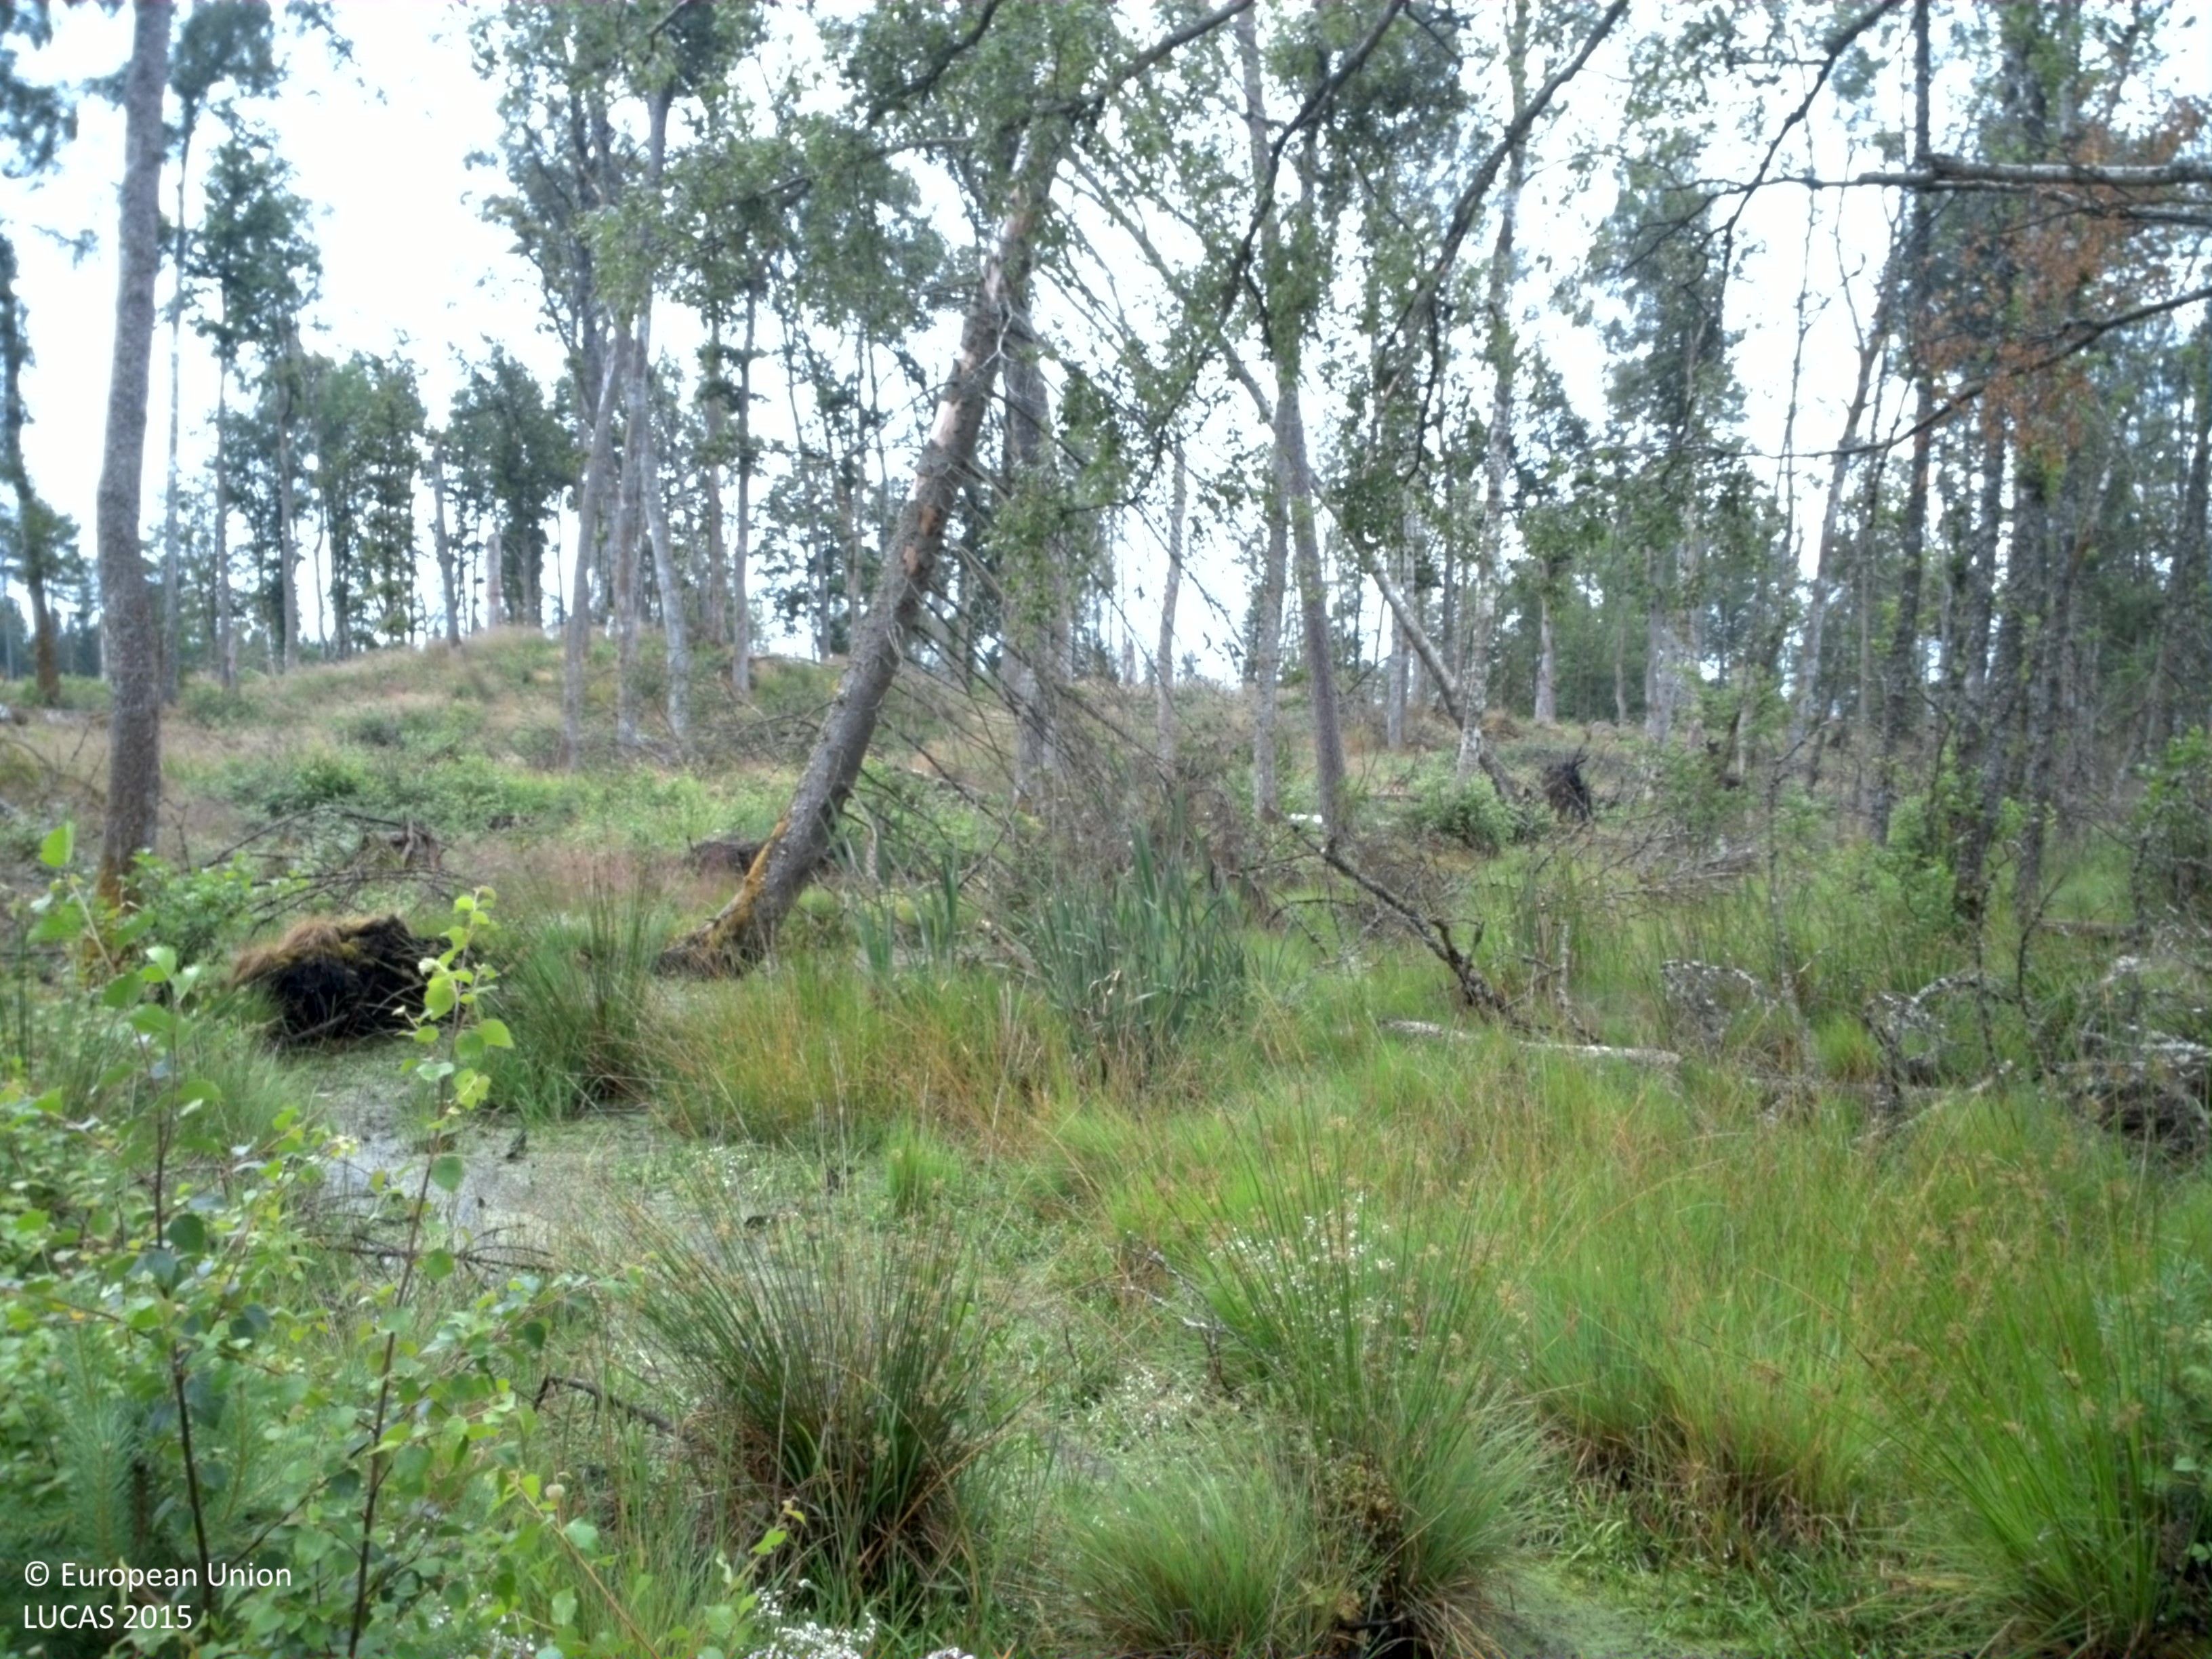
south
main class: Woodland
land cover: Broadleaved woodland
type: hemiboreal forest and nemoral coniferous forest and mixed broadleaved-coniferous forest
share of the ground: > 75 %
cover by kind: broadleaved forest trees 90 %, herbaceous plants 10 %
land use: Forestry
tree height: > 5 m
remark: Clear cut
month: July
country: SE
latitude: 58.3037
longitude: 13.3559
